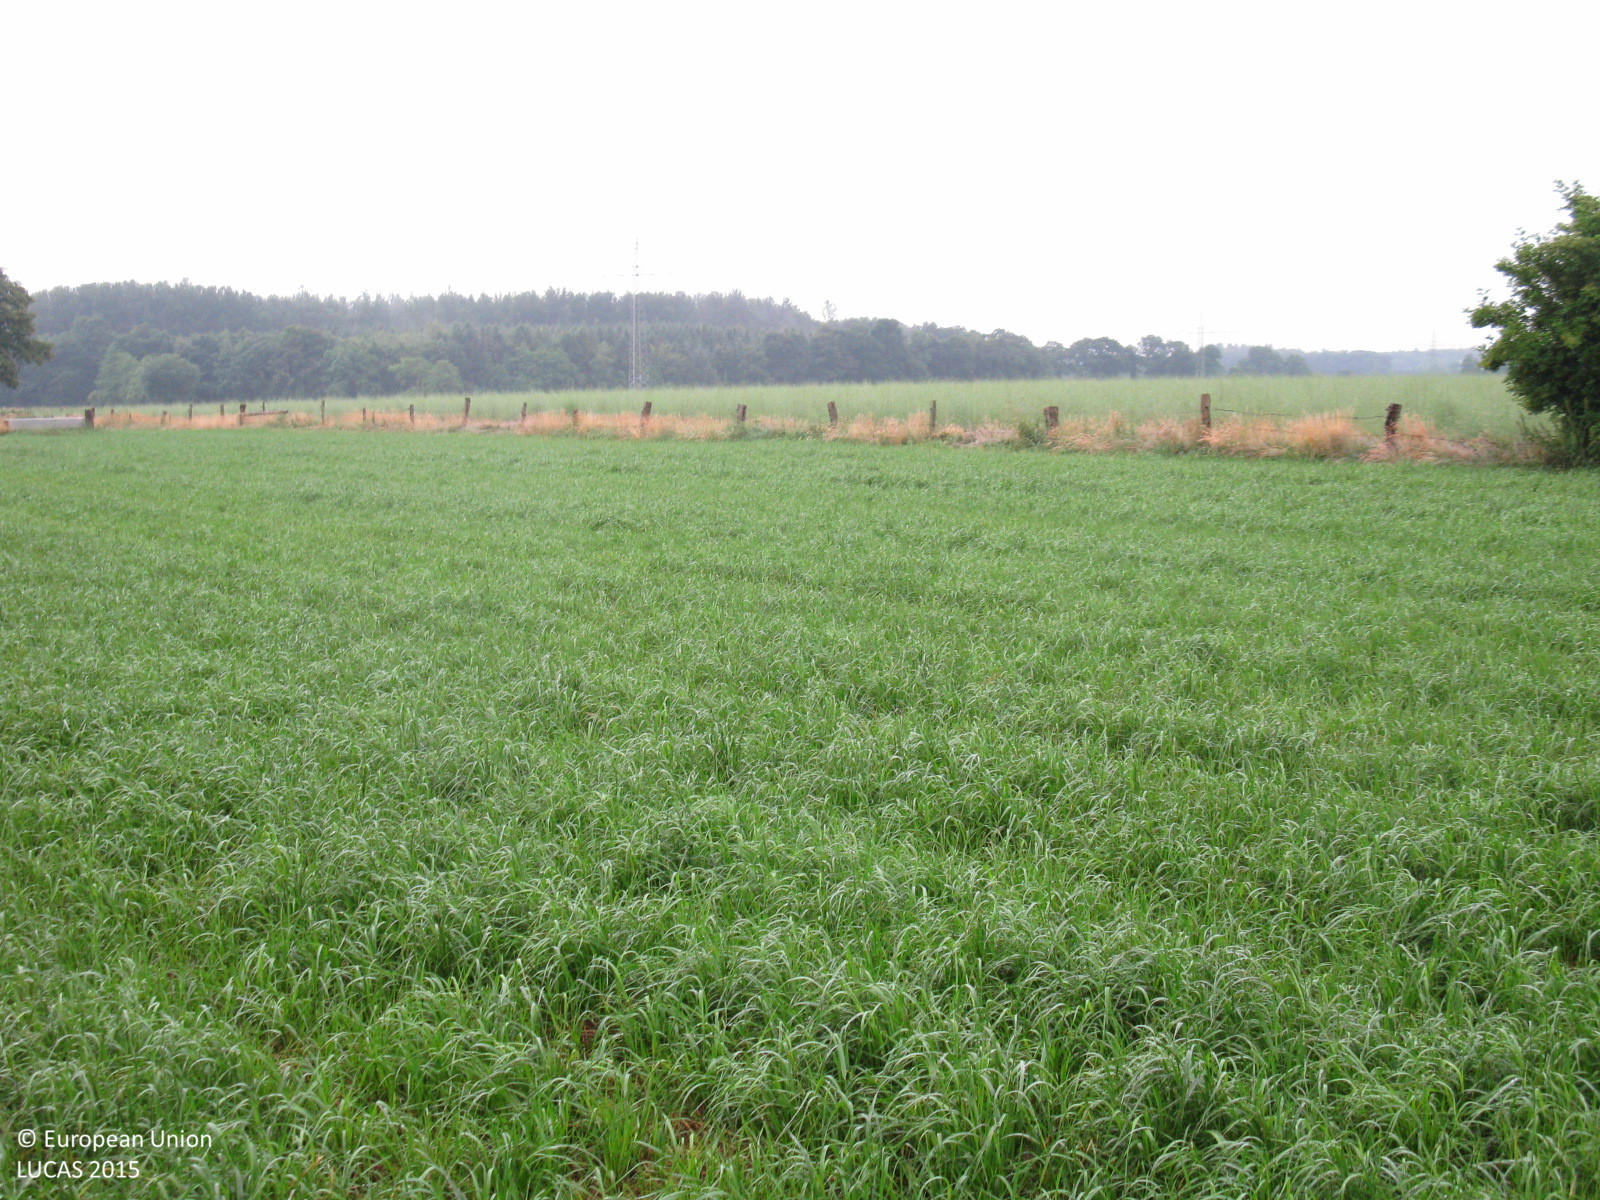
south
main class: Grassland
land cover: Grassland without tree/shrub cover
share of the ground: > 75 %
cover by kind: herbaceous plants 100 %
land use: Agriculture (excluding fallow land and kitchen gardens)
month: July
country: DE
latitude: 53.2772
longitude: 7.9761
